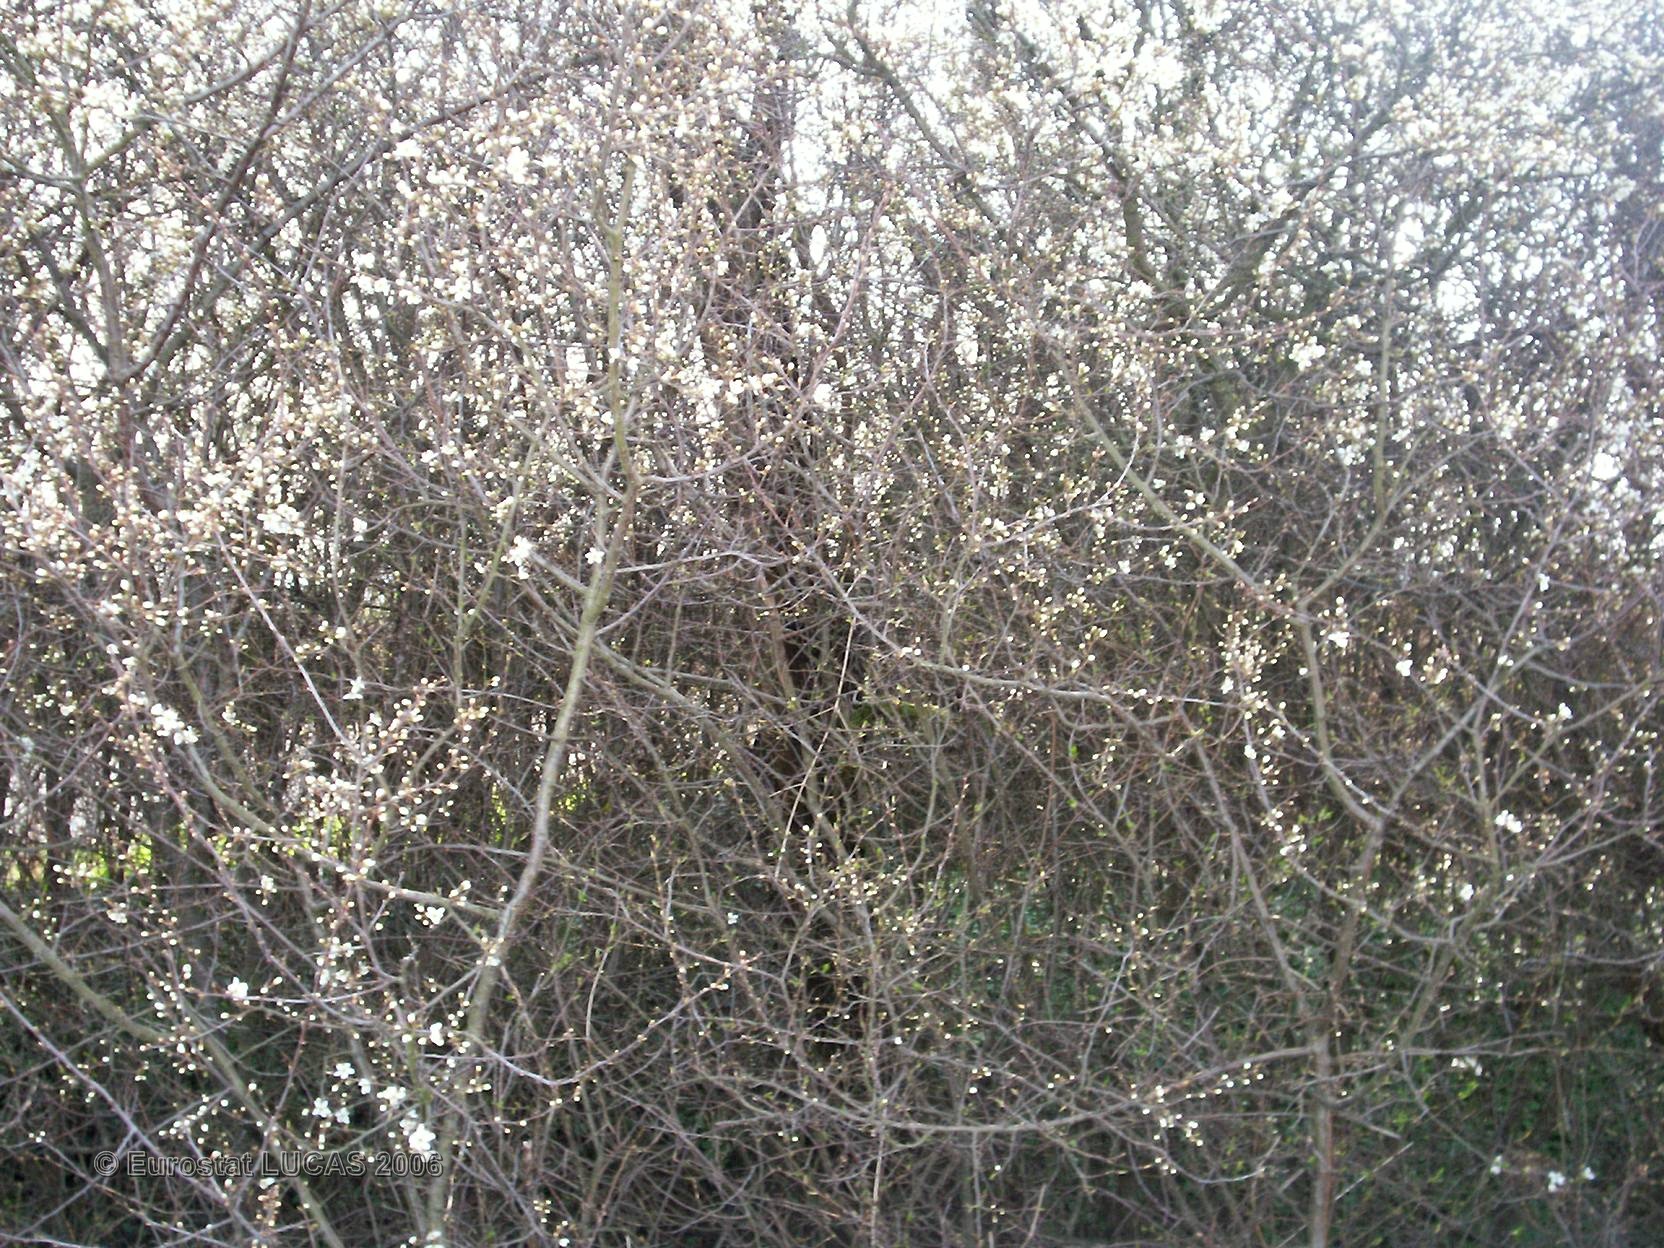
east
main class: Woodland
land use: Unused
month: April
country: FR
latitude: 45.5589
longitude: 4.1484
